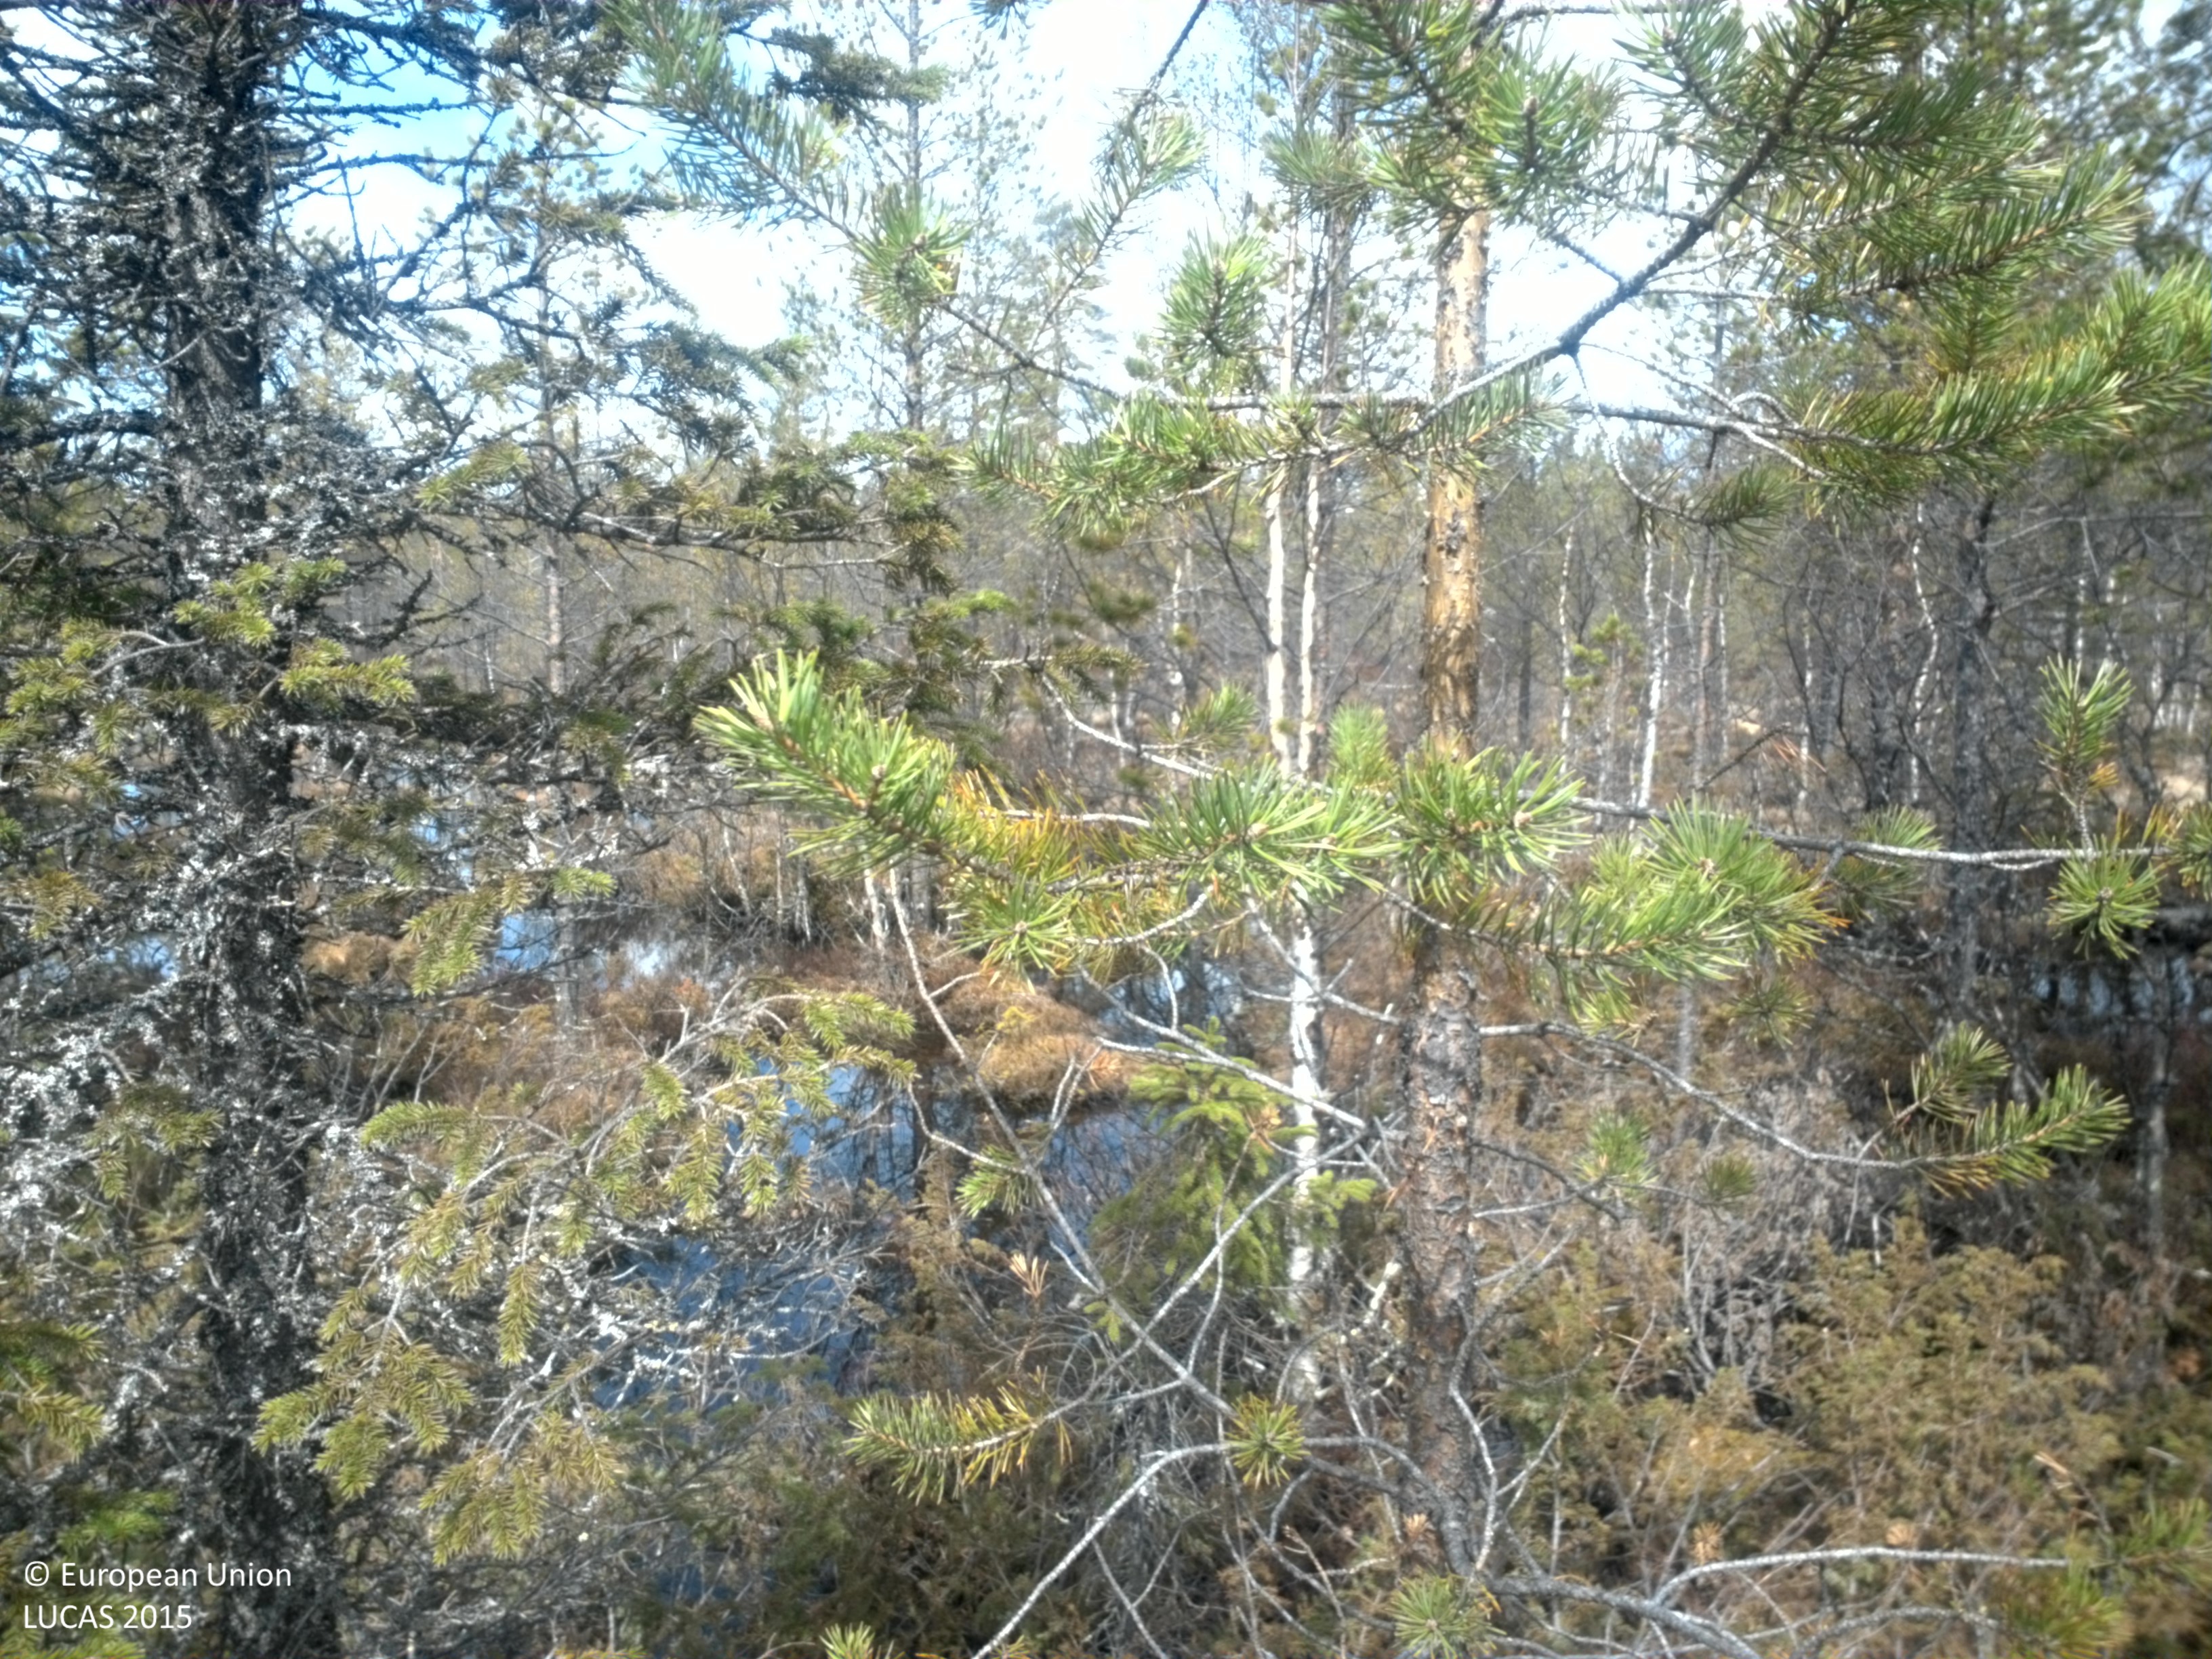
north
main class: Woodland
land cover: Pine dominated mixed woodland
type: boreal forest
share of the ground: 50 - 75 %
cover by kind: coniferous forest trees 50 %, shrubs 30 %, broadleaved forest trees 20 %
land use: Forestry
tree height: > 5 m
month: May
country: SE
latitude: 62.6909
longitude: 13.7928
